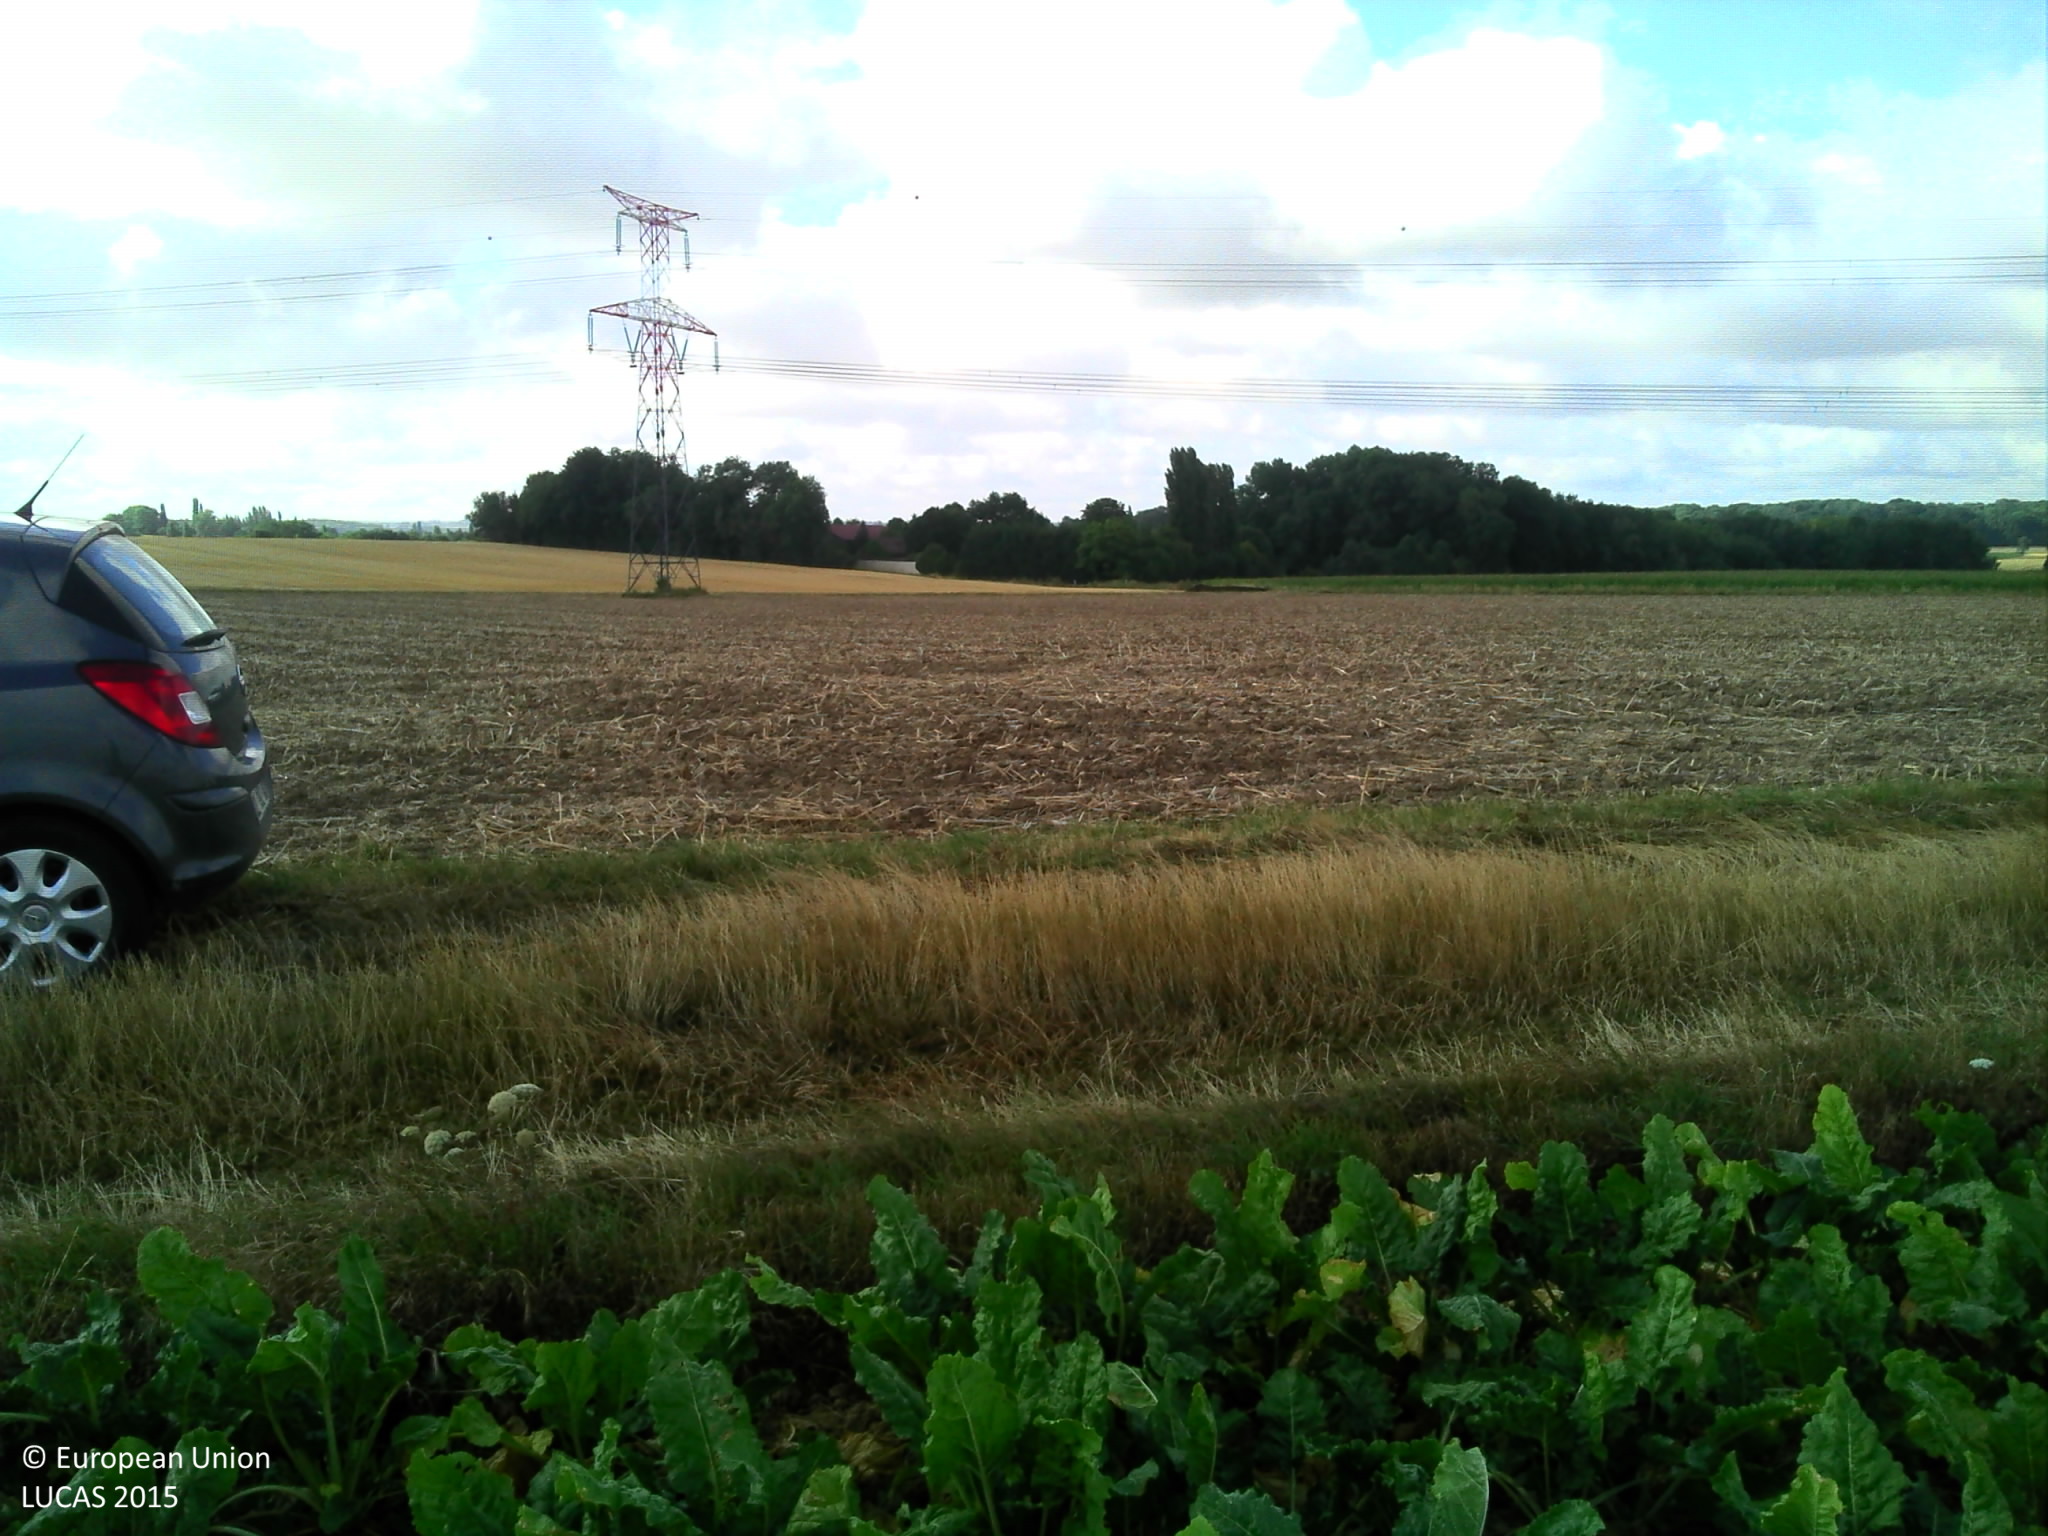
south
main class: Cropland
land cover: Sugar beet
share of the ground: > 75 %
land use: Agriculture (excluding fallow land and kitchen gardens)
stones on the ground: < 10 %
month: July
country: FR
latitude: 48.6170
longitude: 3.0330
